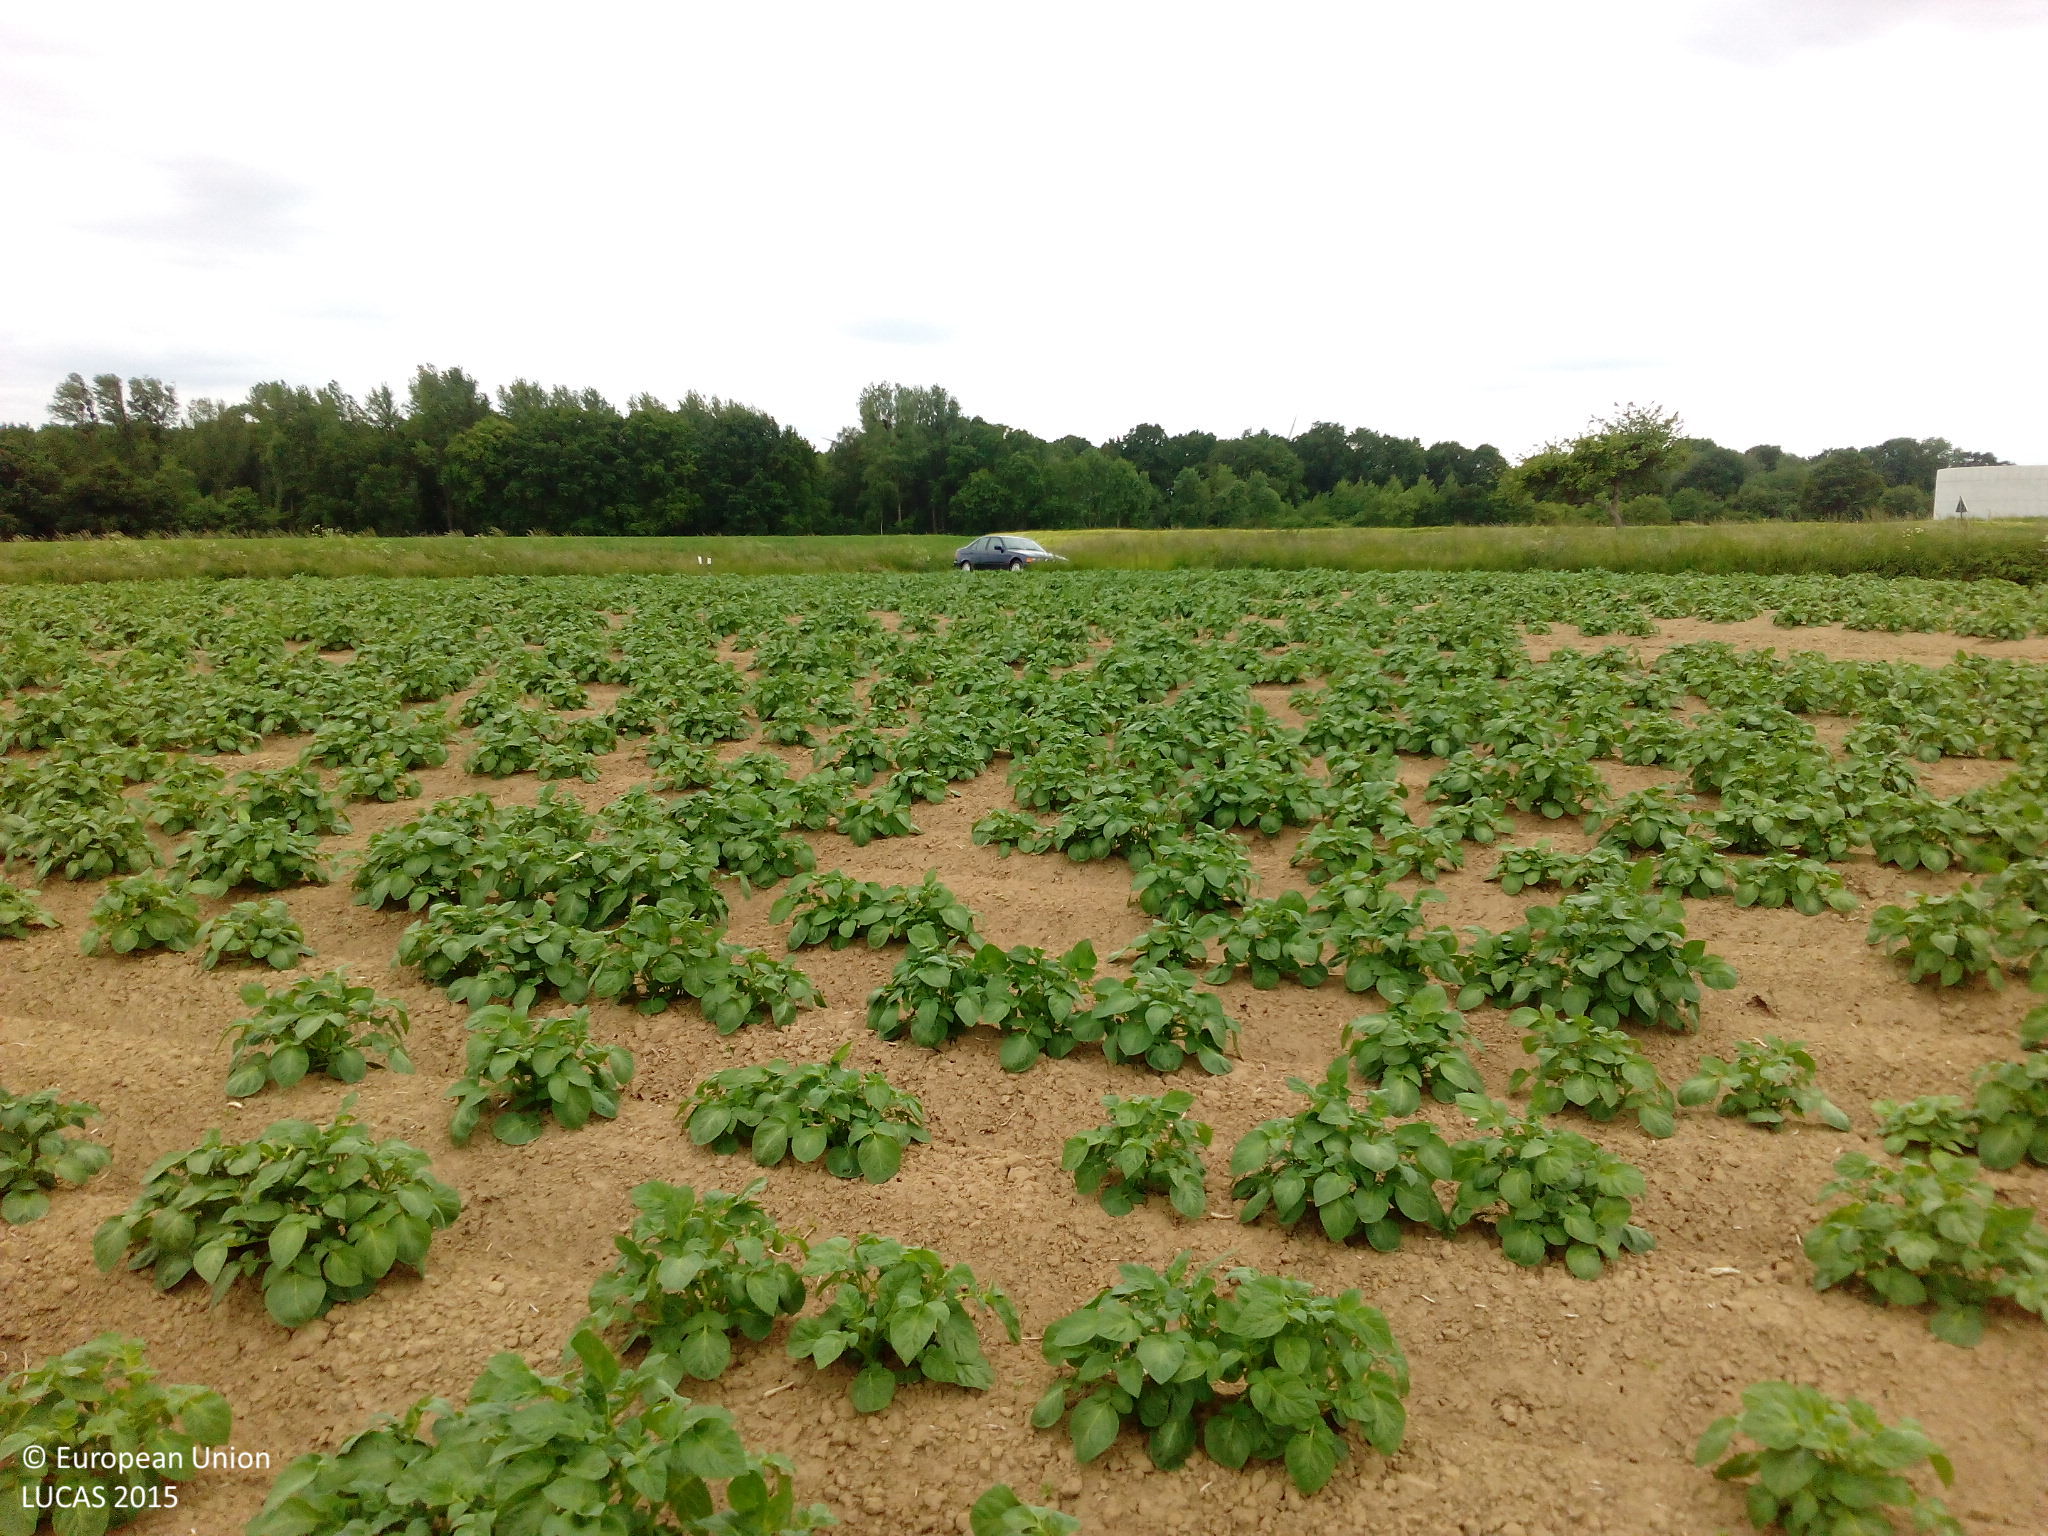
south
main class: Cropland
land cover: Potatoes
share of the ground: 10 - 25 %
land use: Agriculture (excluding fallow land and kitchen gardens)
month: June
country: DE
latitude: 51.5874
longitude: 7.9942
